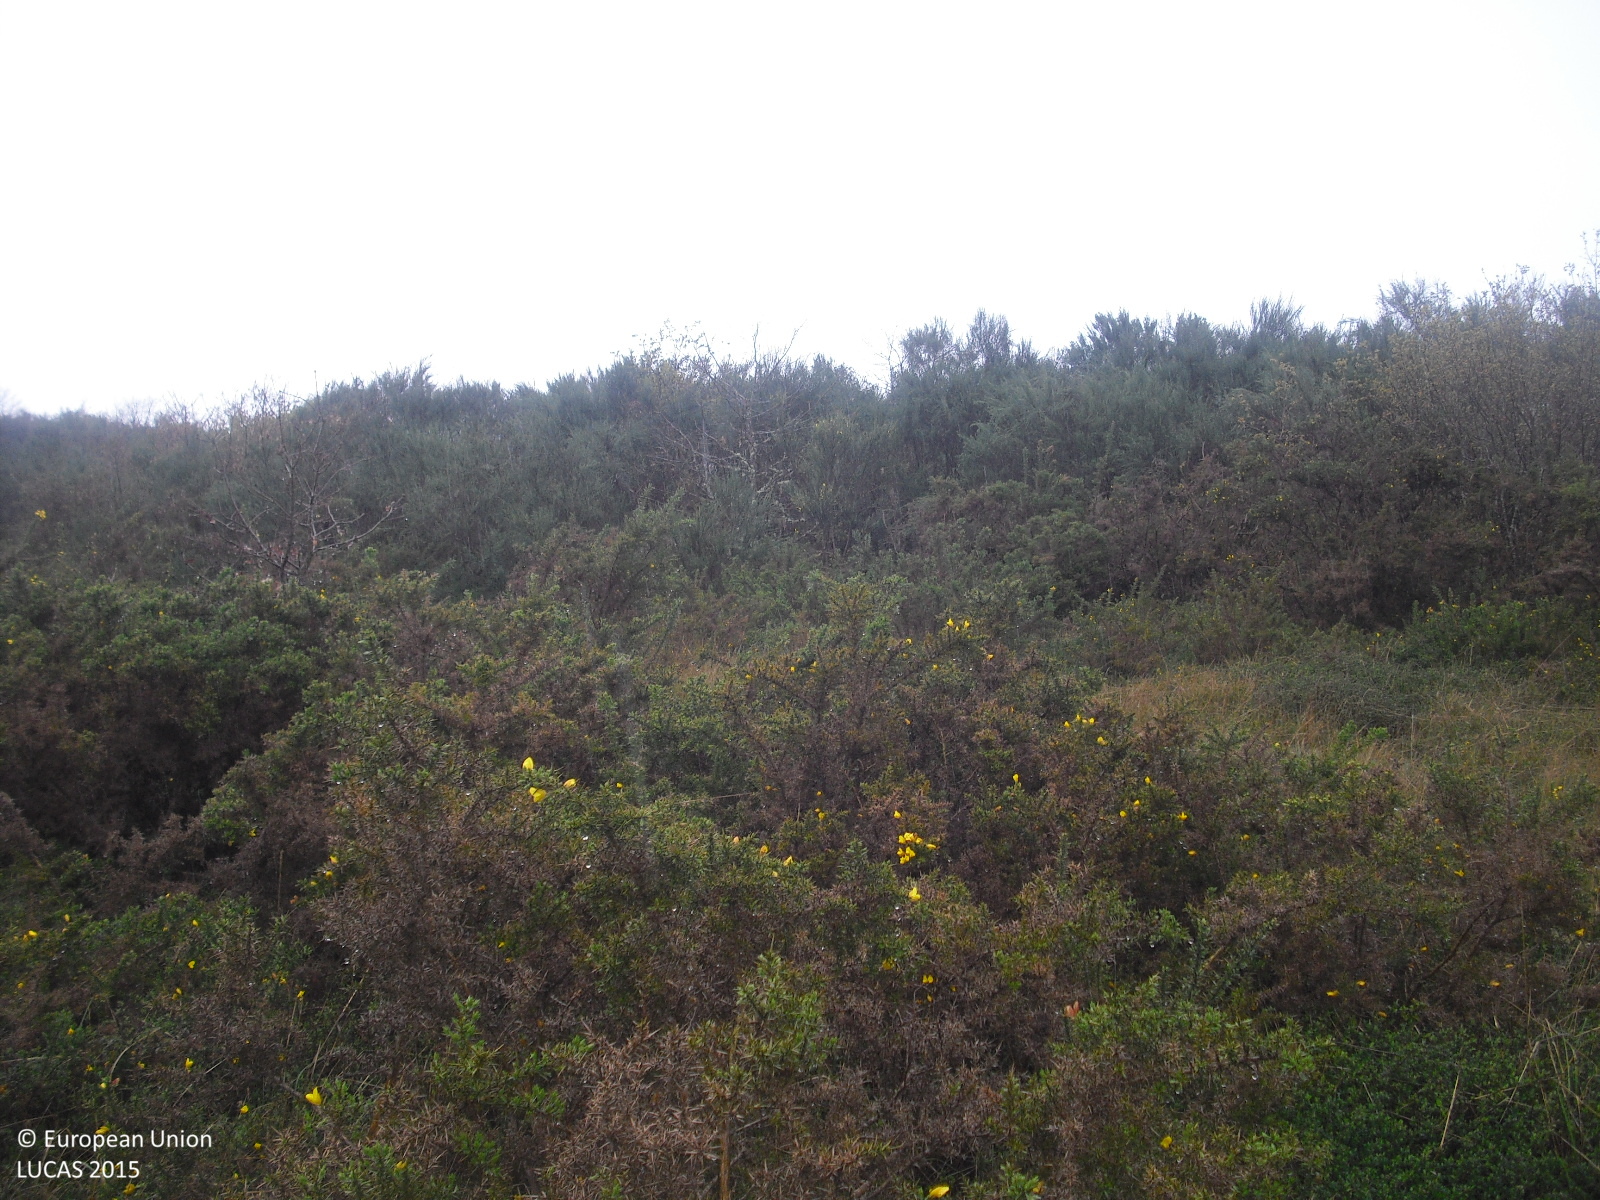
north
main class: Shrubland
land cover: Shrubland with sparse tree cover
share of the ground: 50 - 75 %
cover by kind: shrubs 85 %, herbaceous plants 10 %, broadleaved forest trees 5 %
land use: Abandoned areas
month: April
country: ES
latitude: 42.1203
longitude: -7.8668
